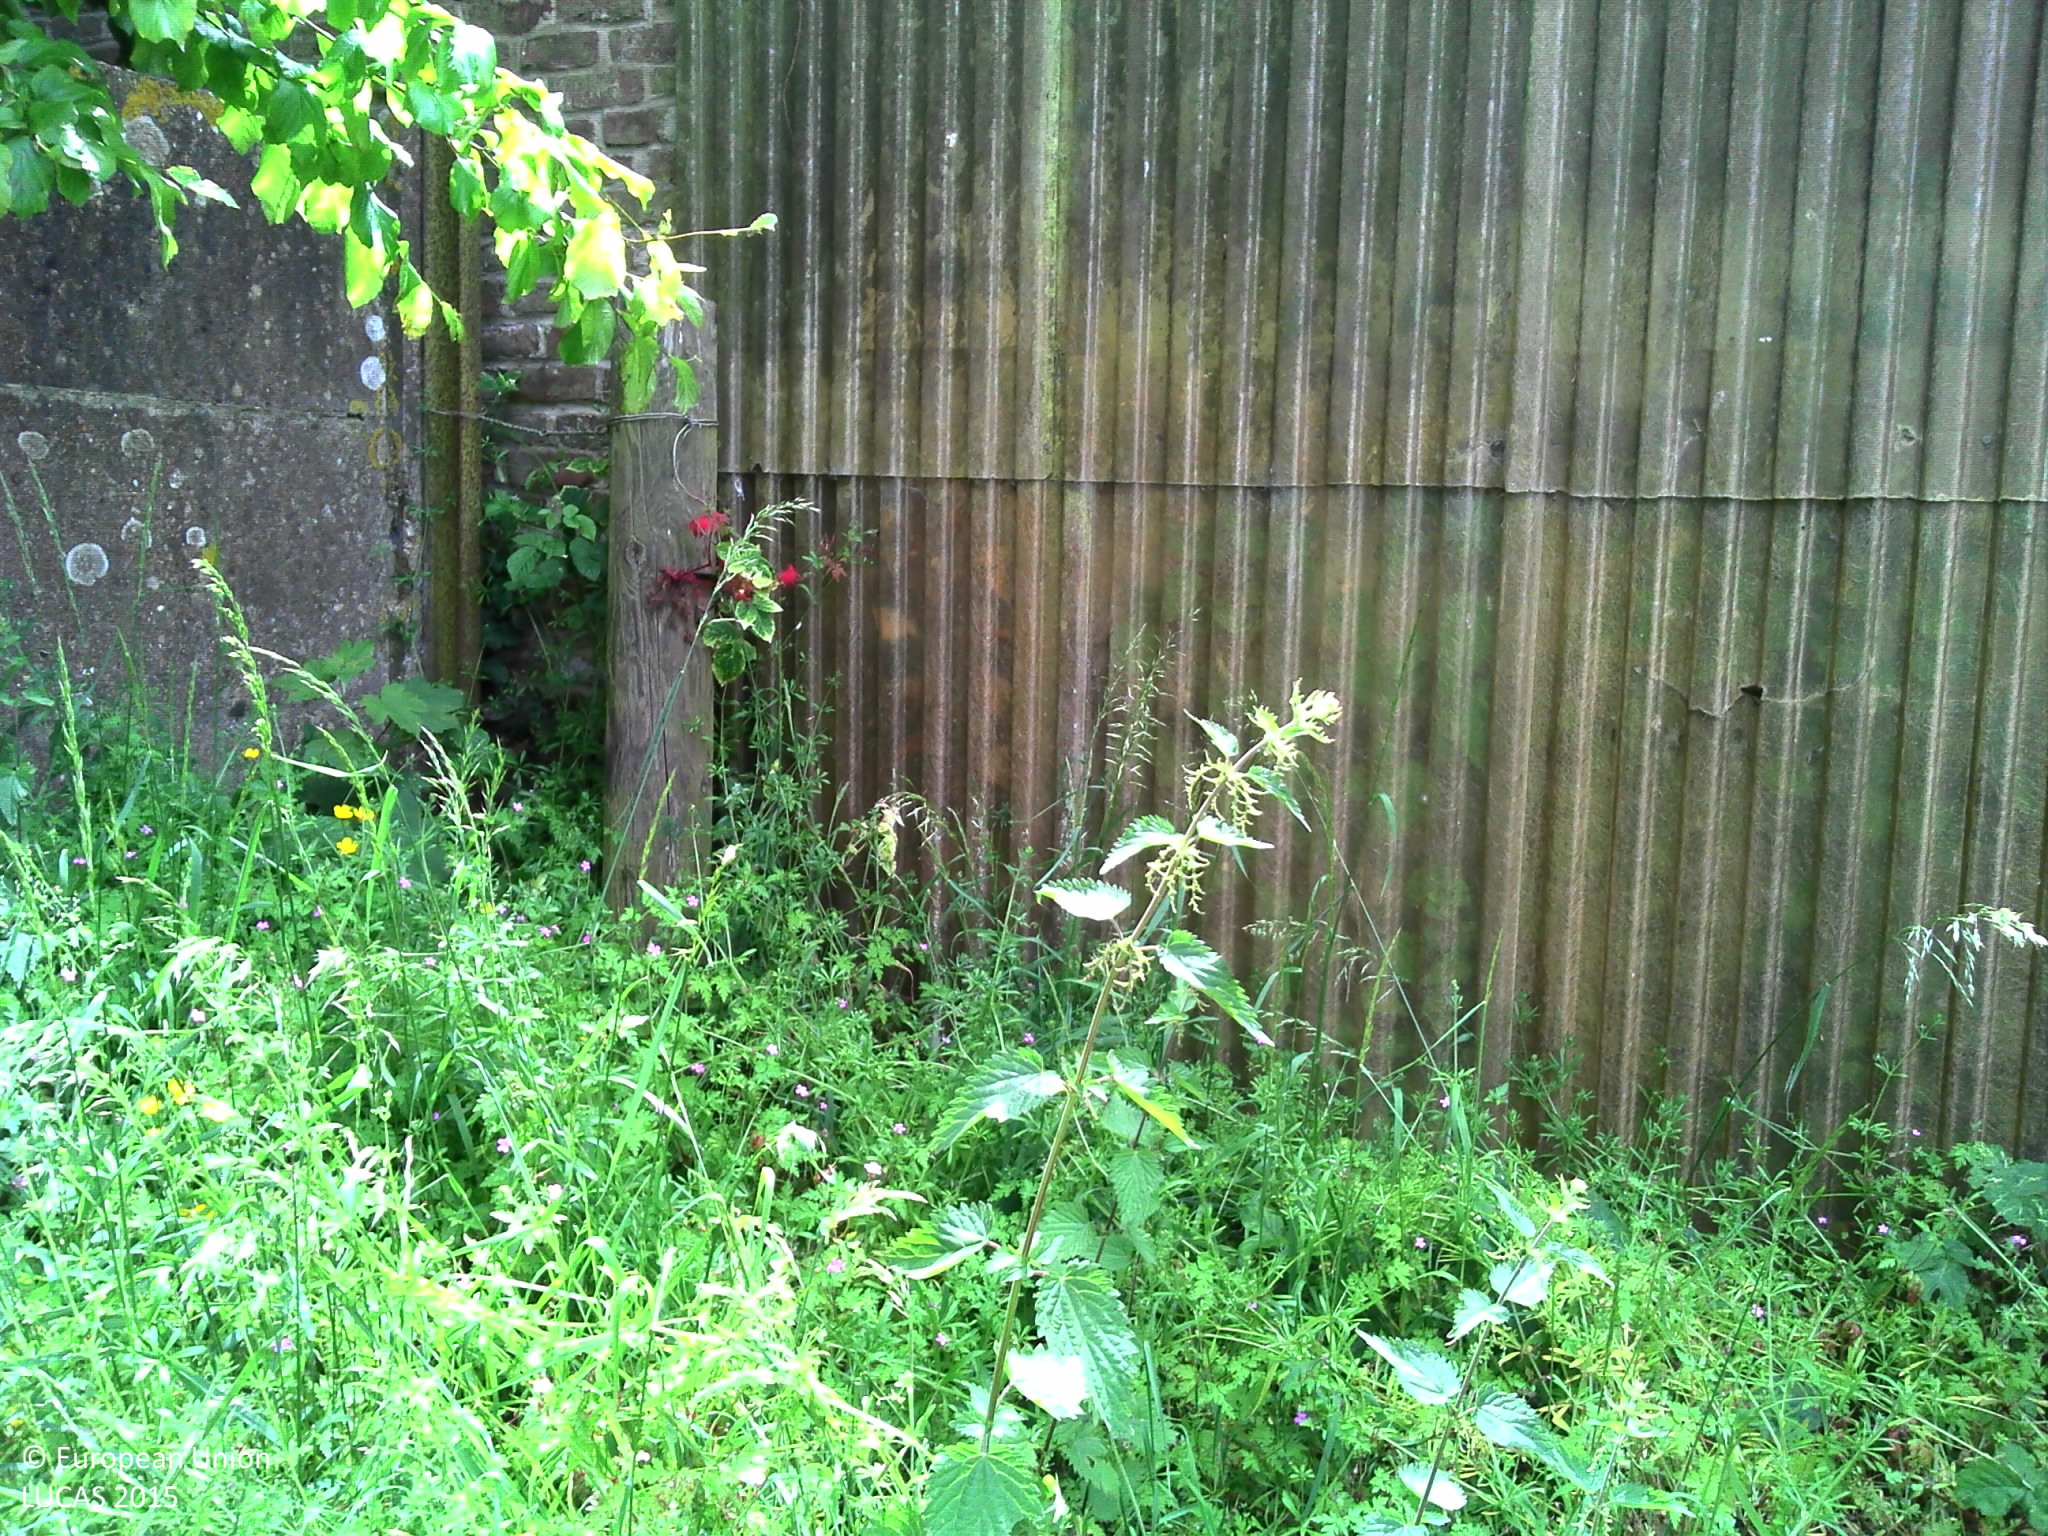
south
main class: Grassland
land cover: Grassland without tree/shrub cover
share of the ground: > 75 %
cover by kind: herbaceous plants 80 %
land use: Semi-natural and natural areas not in use
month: June
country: FR
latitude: 50.5112
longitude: 2.4426
